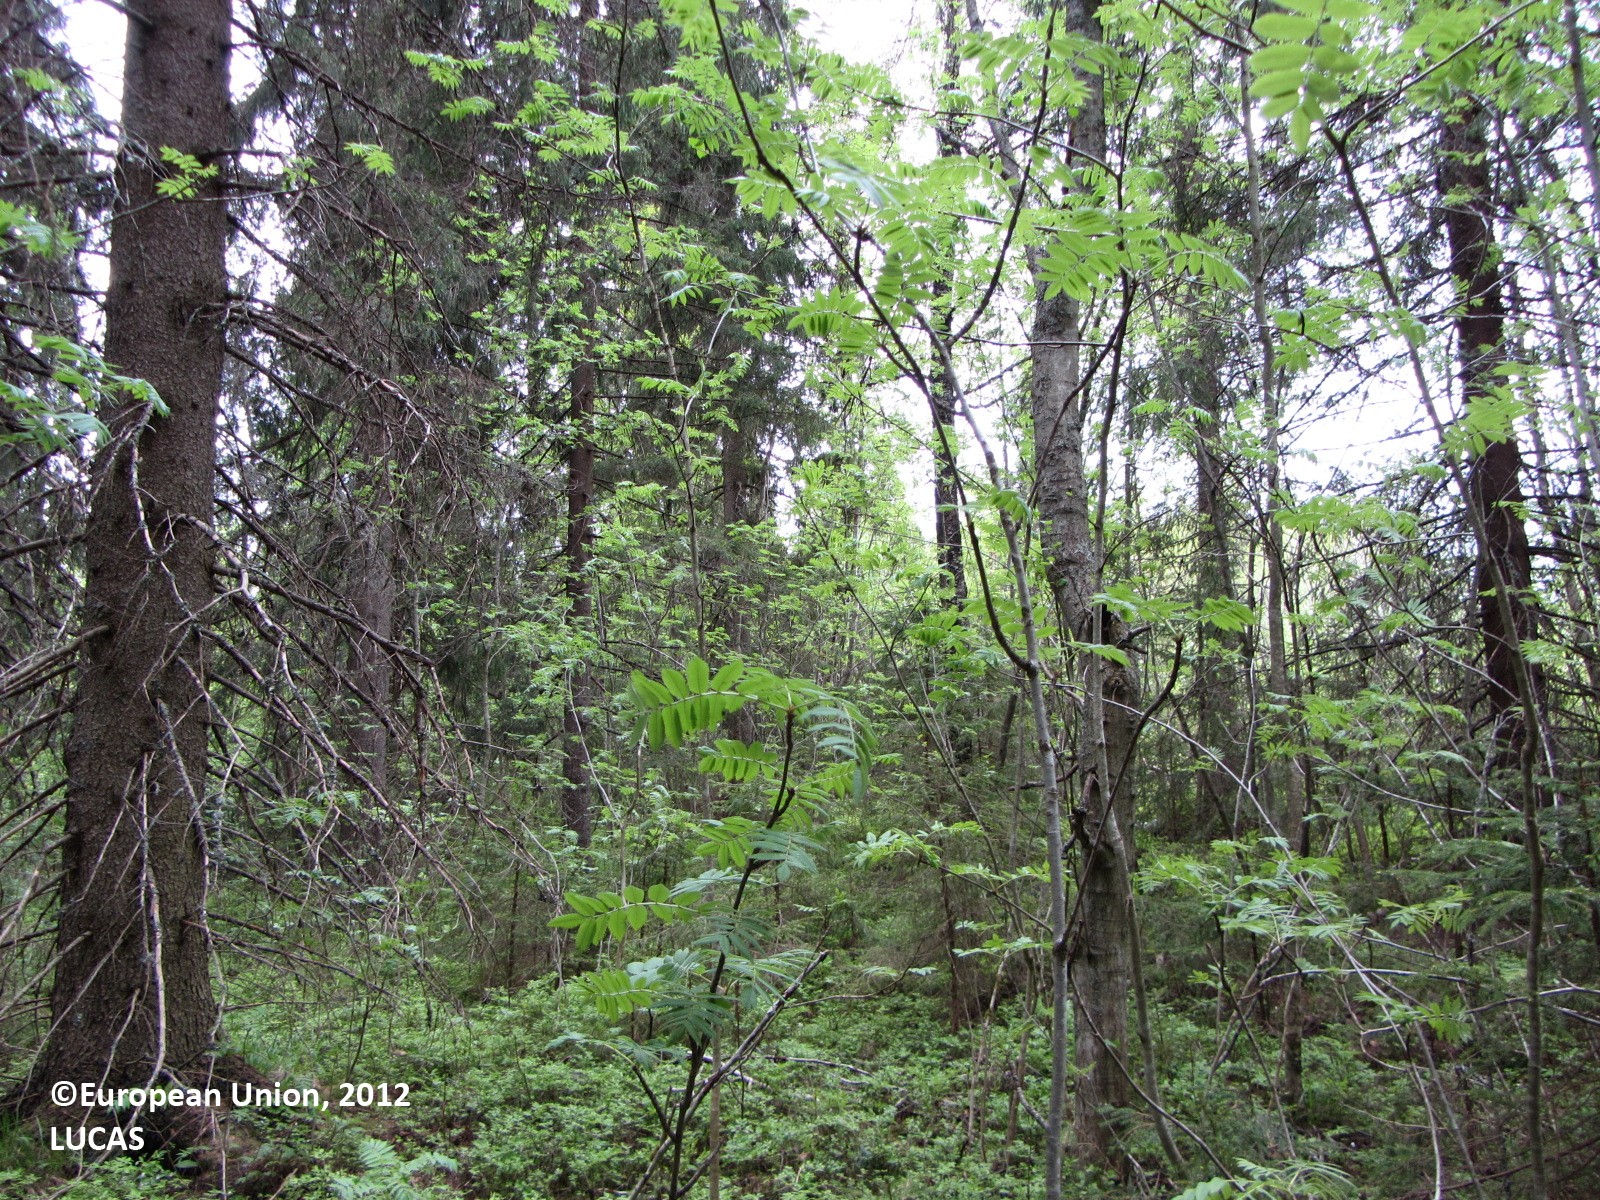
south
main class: Woodland
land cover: Spruce dominated mixed woodland
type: boreal forest
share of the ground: > 75 %
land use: Forestry
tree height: > 5 m
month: May
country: FI
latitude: 62.3060
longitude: 25.4459
